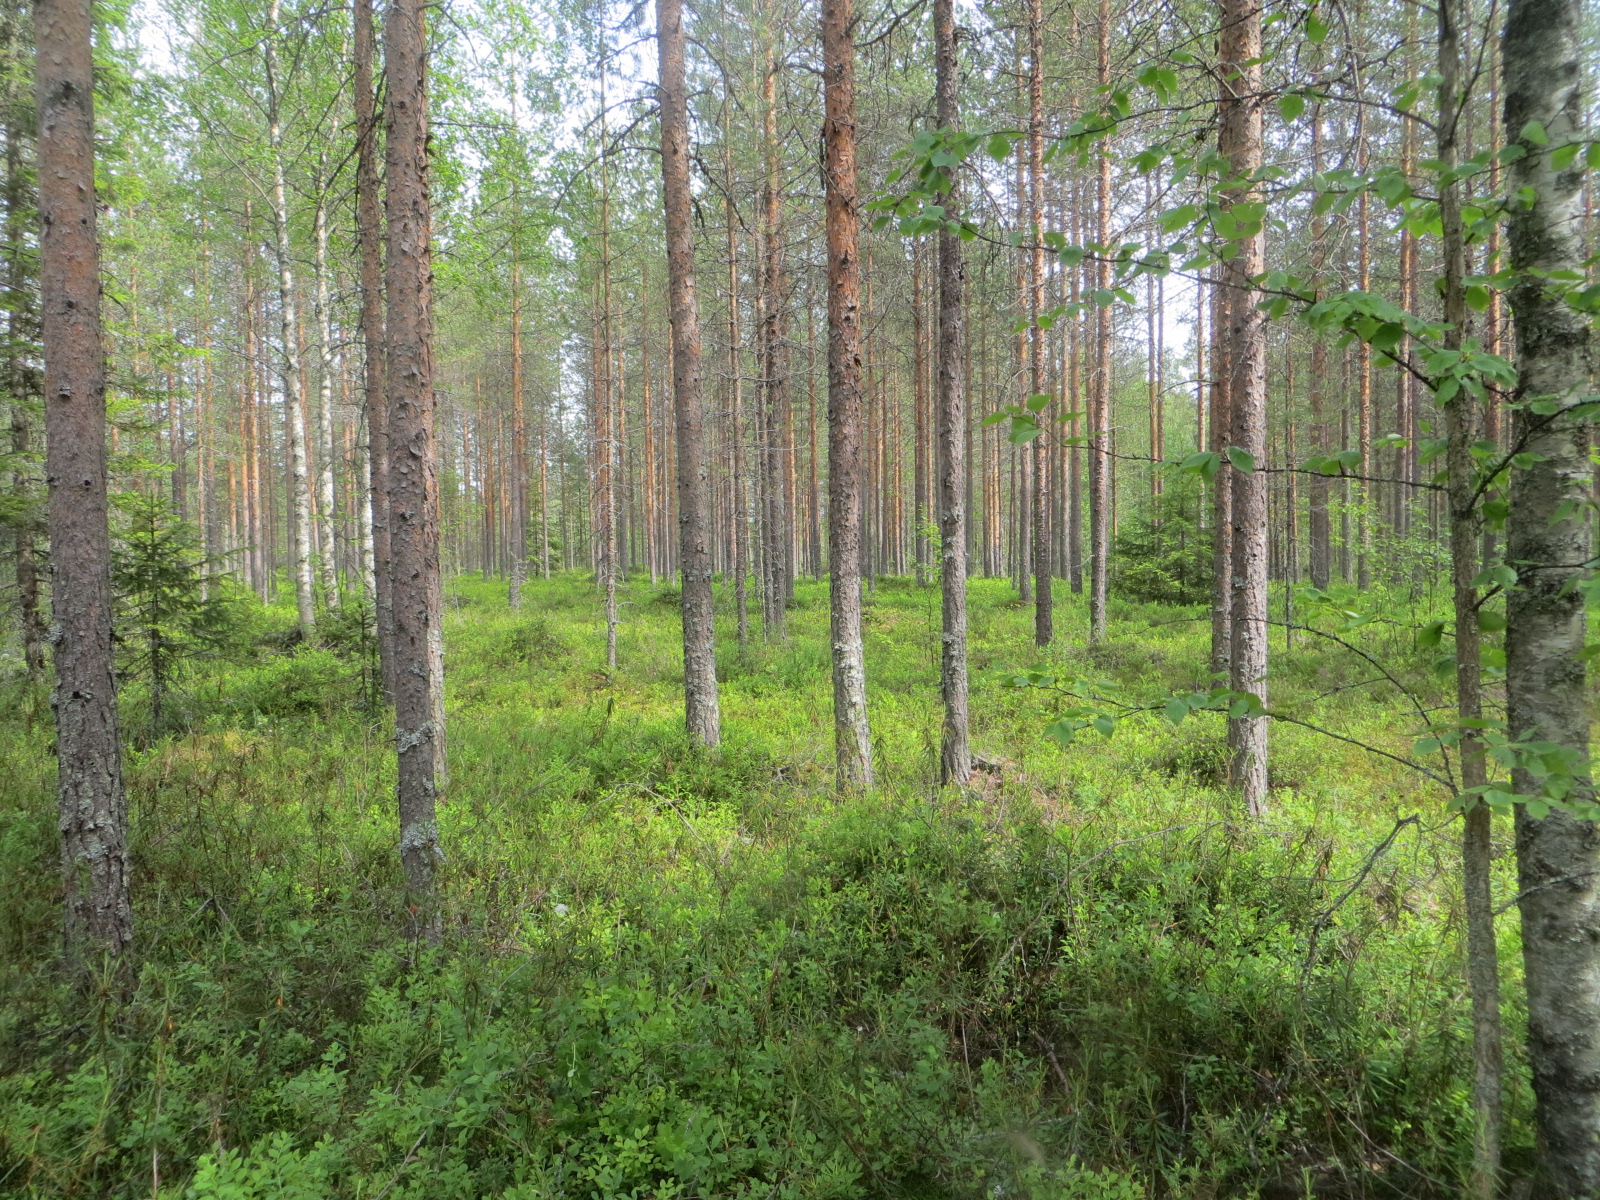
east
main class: Woodland
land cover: Pine dominated coniferous woodland
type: boreal forest
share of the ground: 50 - 75 %
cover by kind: coniferous forest trees 65 %, shrubs 30 %, broadleaved forest trees 5 %
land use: Forestry
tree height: > 5 m
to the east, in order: Pine dominated coniferous woodland
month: July
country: FI
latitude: 65.3676
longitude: 25.8924
